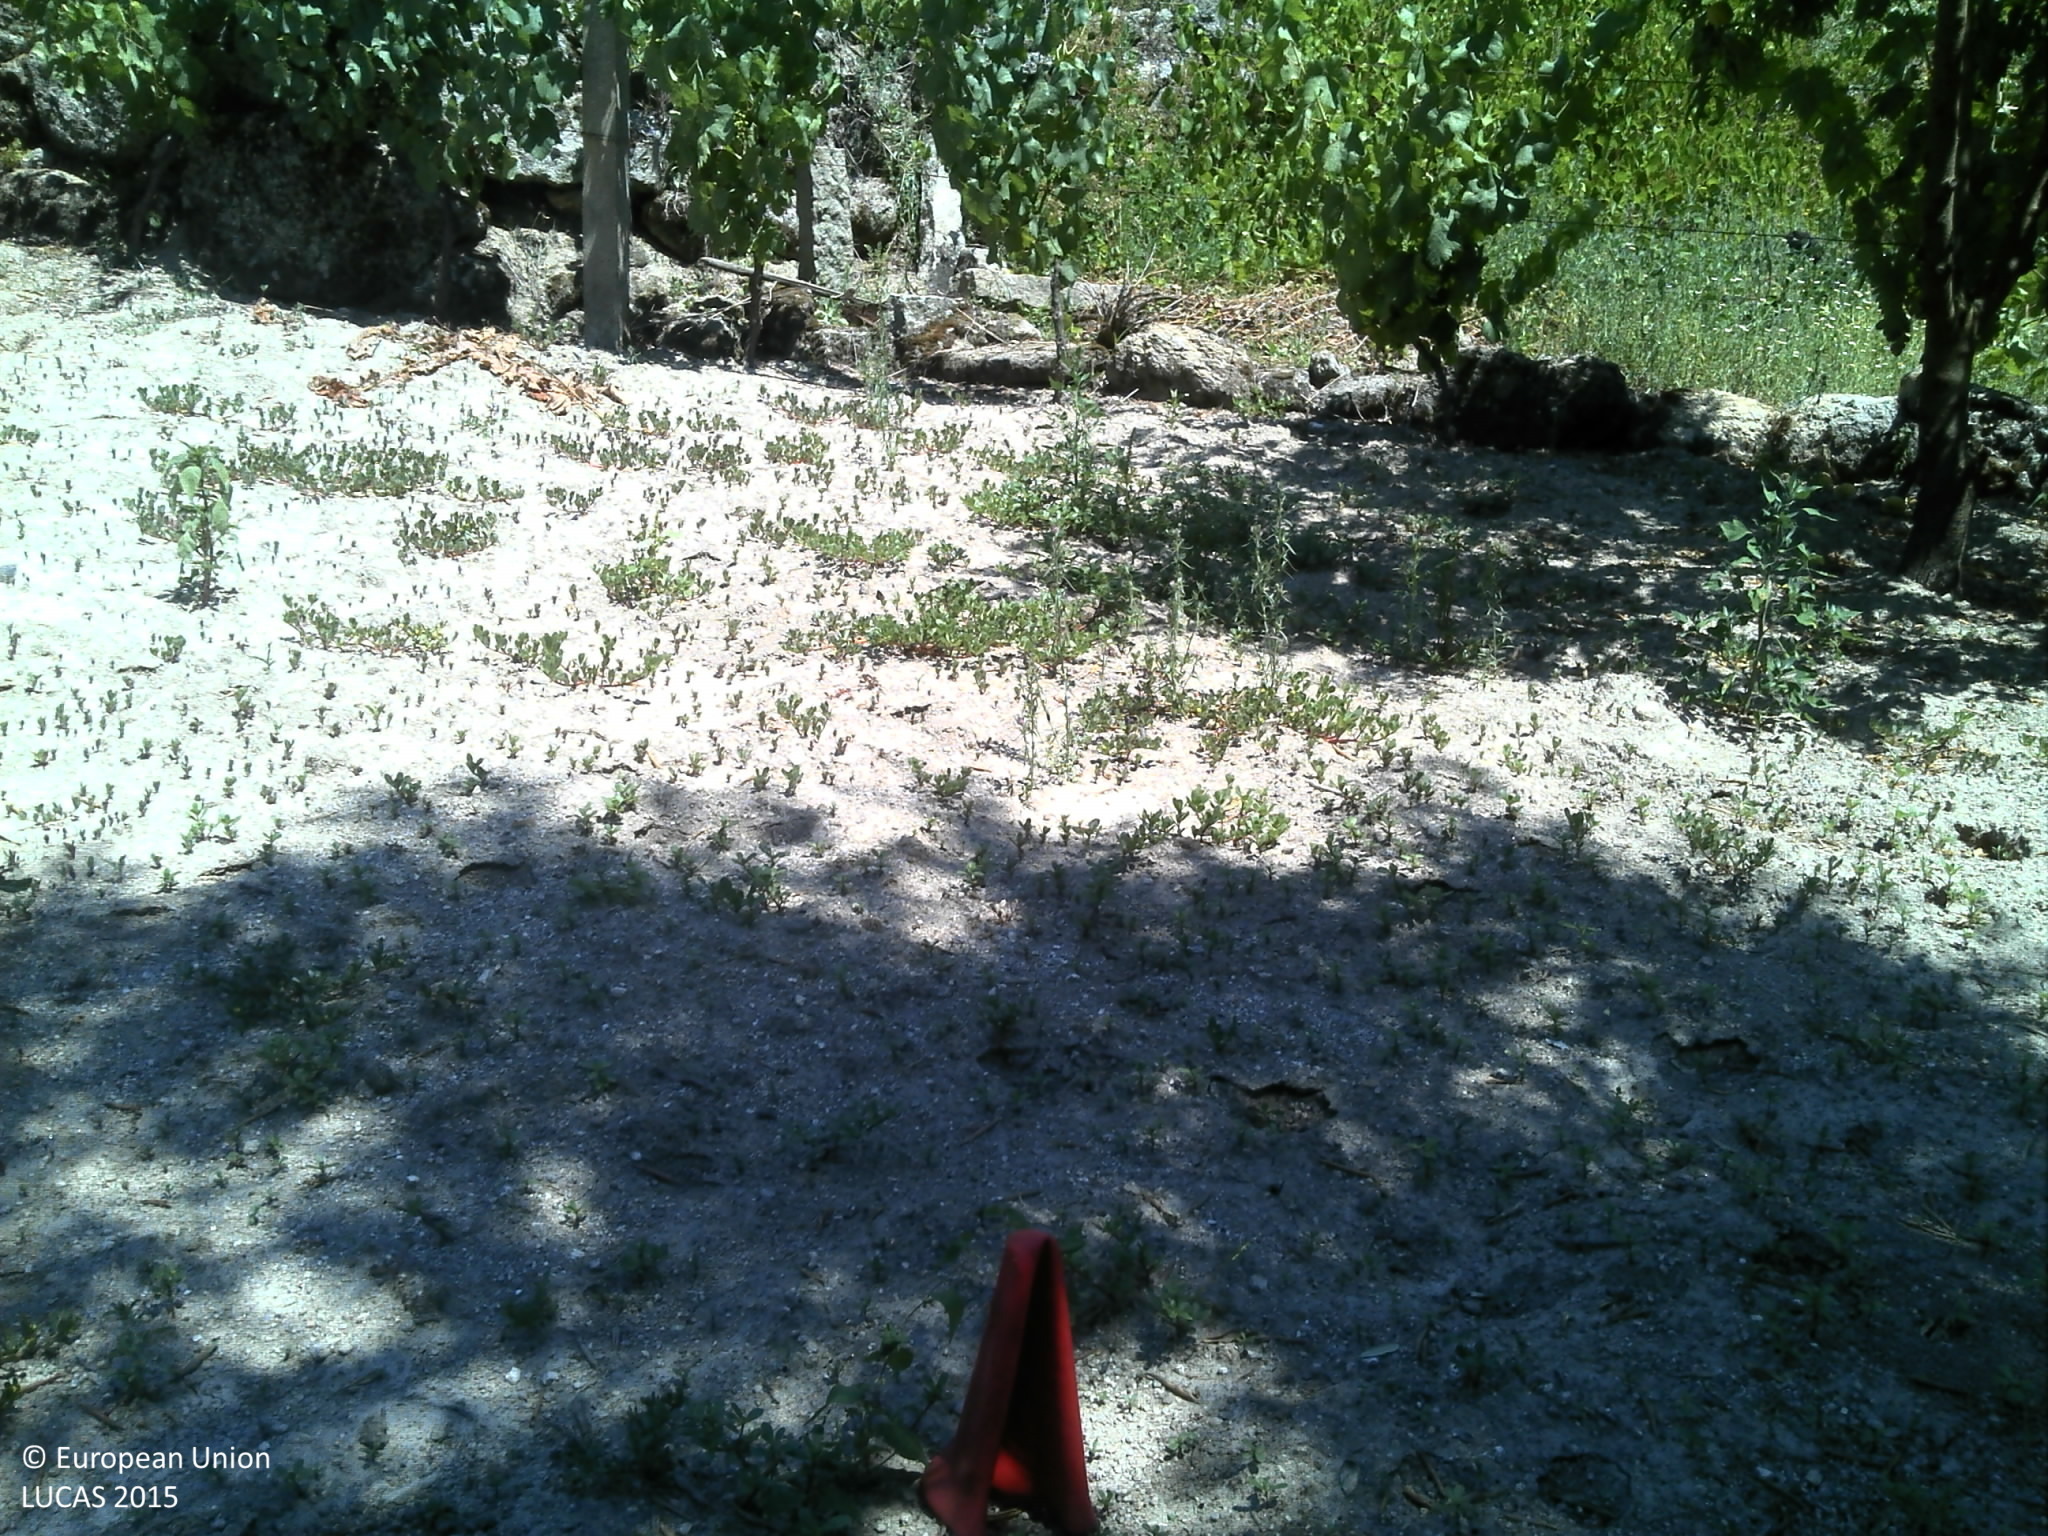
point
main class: Grassland
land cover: Grassland with sparse tree/shrub cover
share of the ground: 10 - 25 %
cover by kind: unconsolidated bare surface 70 %, herbaceous plants 25 %, broadleaved forest trees 5 %
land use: Agriculture (excluding fallow land and kitchen gardens)
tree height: > 5 m
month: June
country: PT
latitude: 40.5516
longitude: -7.9671
